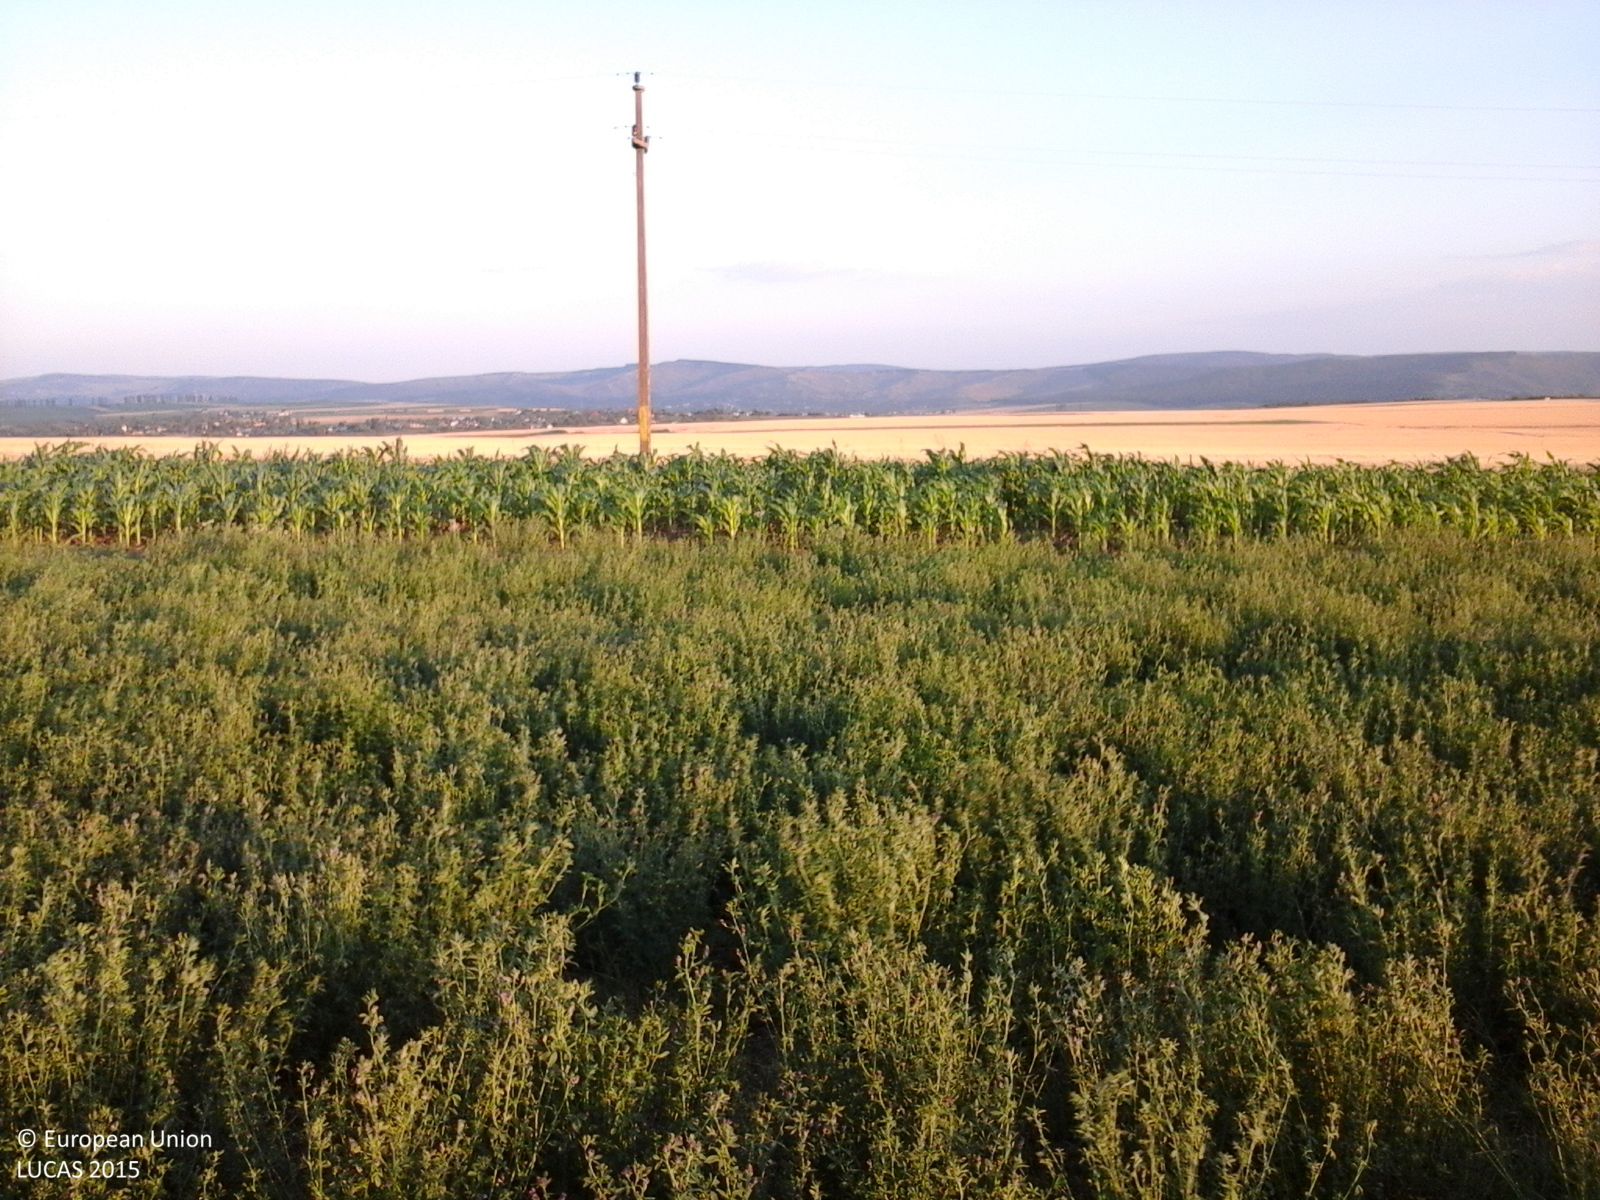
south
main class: Cropland
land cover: Lucerne
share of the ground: > 75 %
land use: Agriculture (excluding fallow land and kitchen gardens)
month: June
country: RO
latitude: 47.1343
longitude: 27.4241
